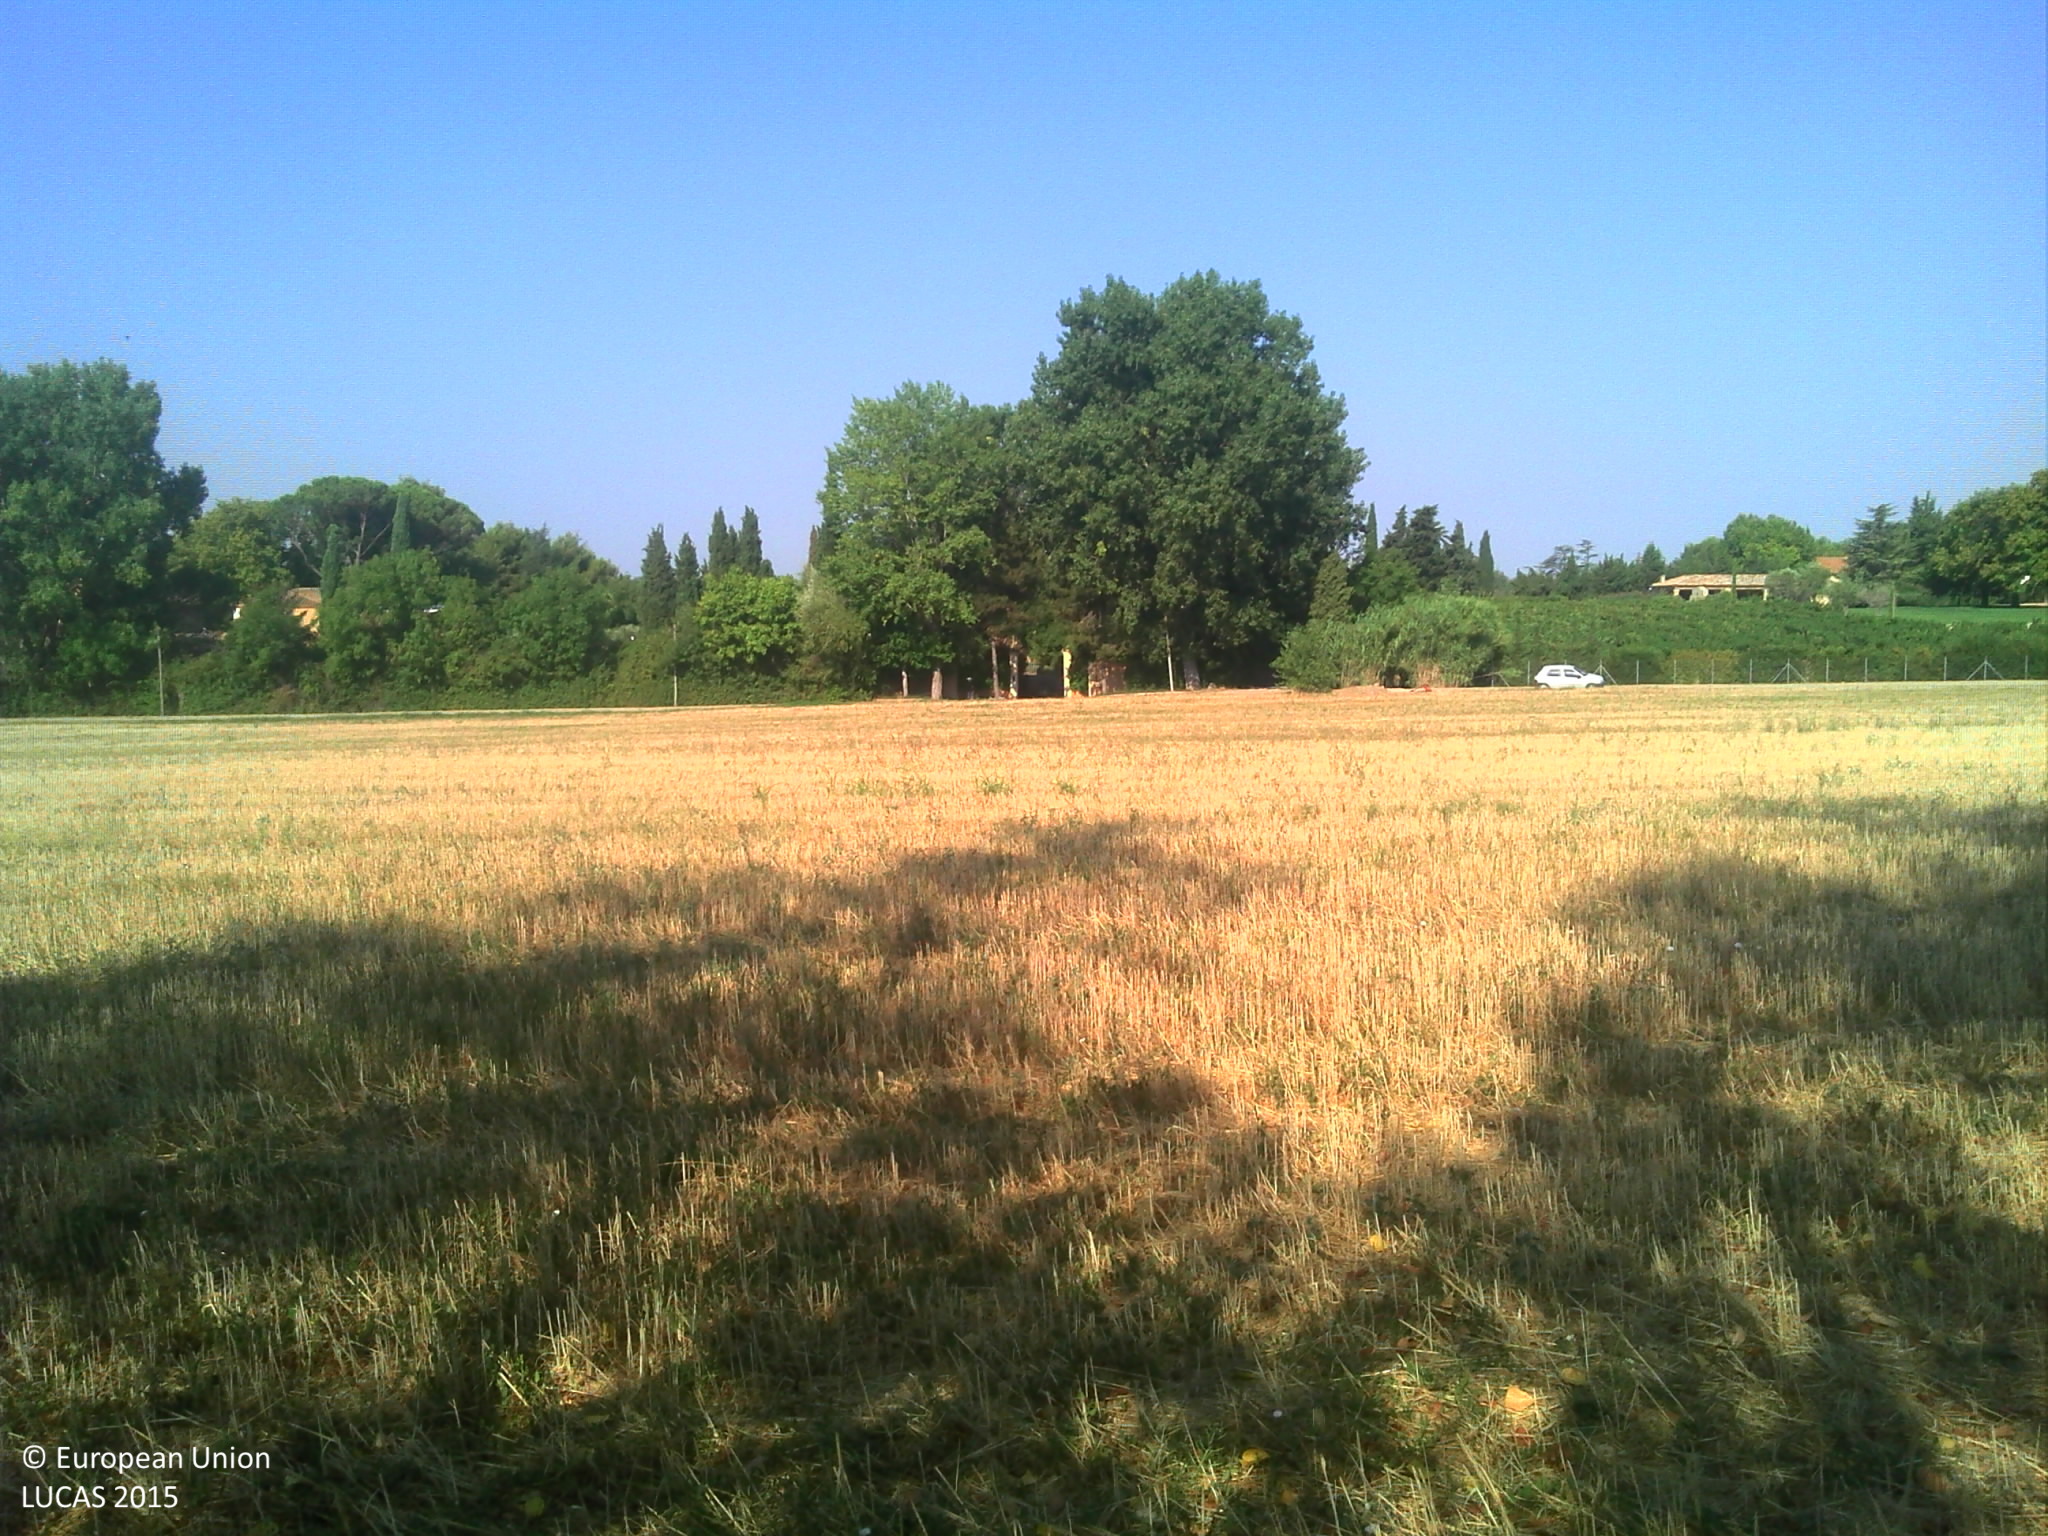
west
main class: Cropland
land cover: Durum wheat
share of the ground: > 75 %
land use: Agriculture (excluding fallow land and kitchen gardens)
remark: Harvested field
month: August
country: FR
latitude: 43.5829
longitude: 5.4644
